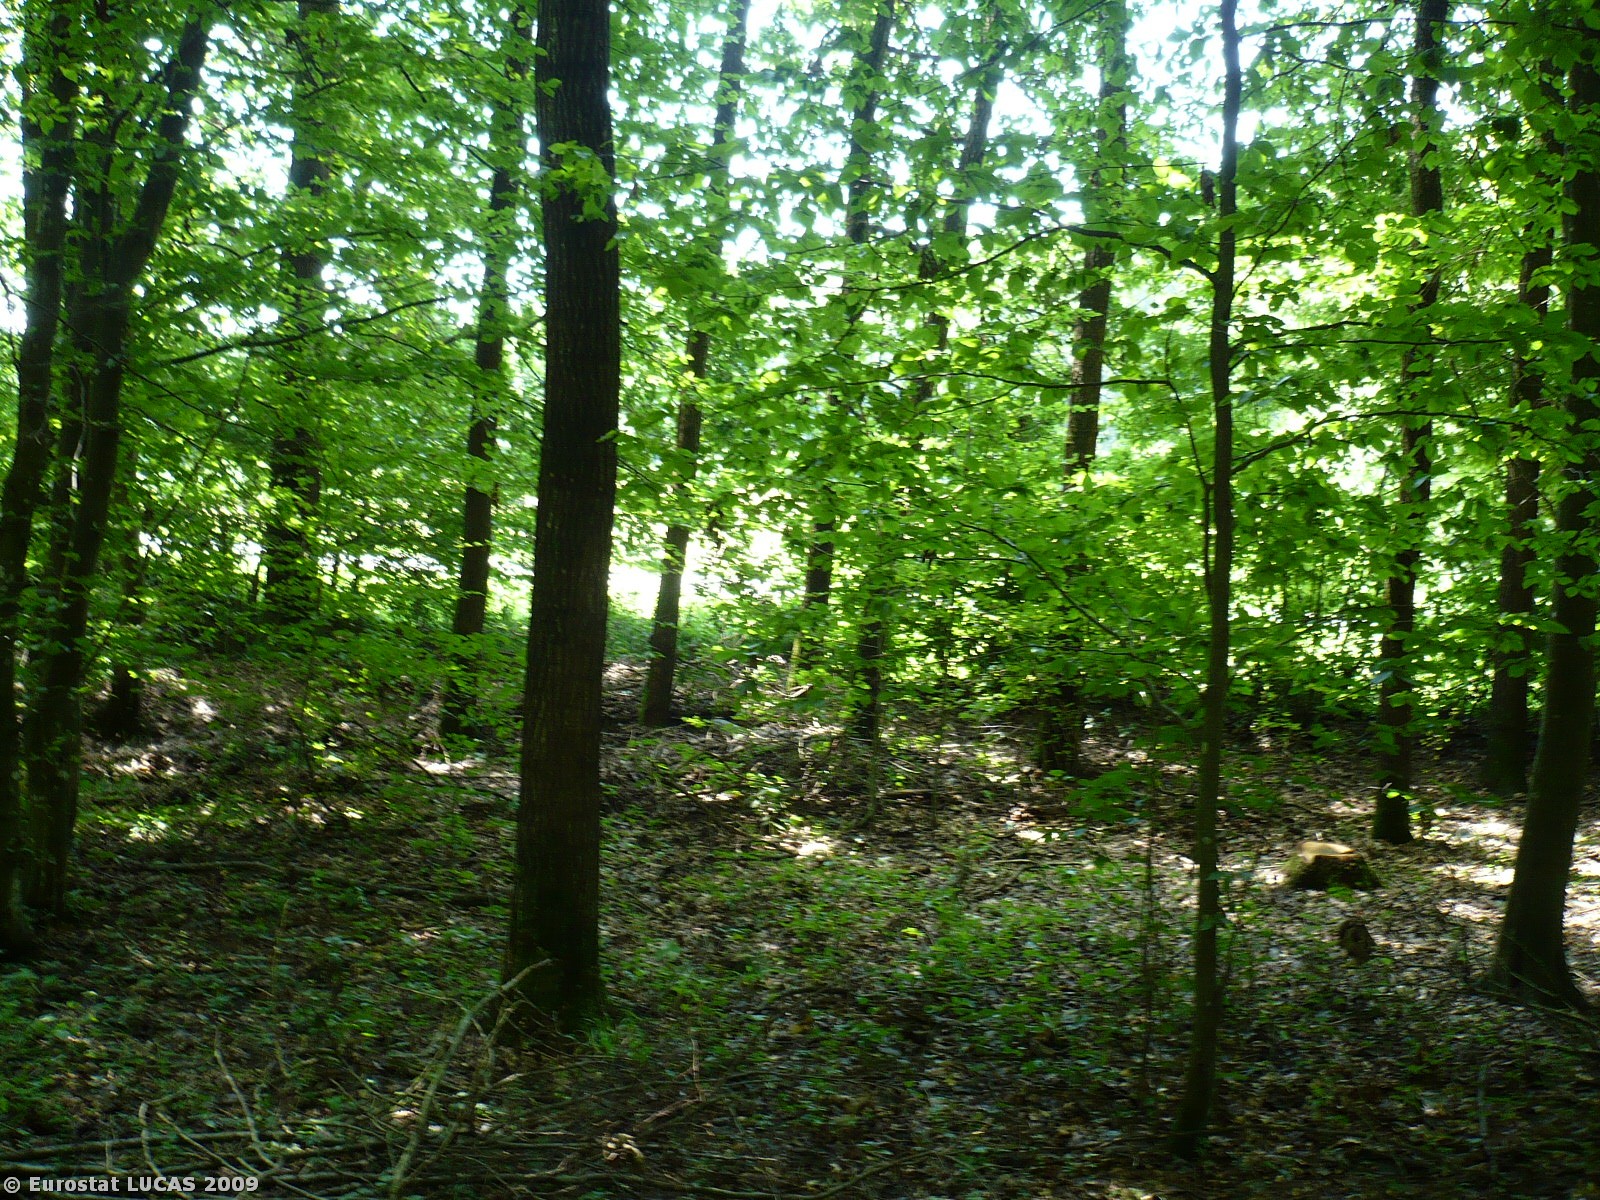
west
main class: Woodland
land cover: Broadleaved woodland
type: mesophytic deciduous forest
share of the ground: > 75 %
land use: Forestry
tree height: > 5 m
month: July
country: SI
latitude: 46.6688
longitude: 16.3404
